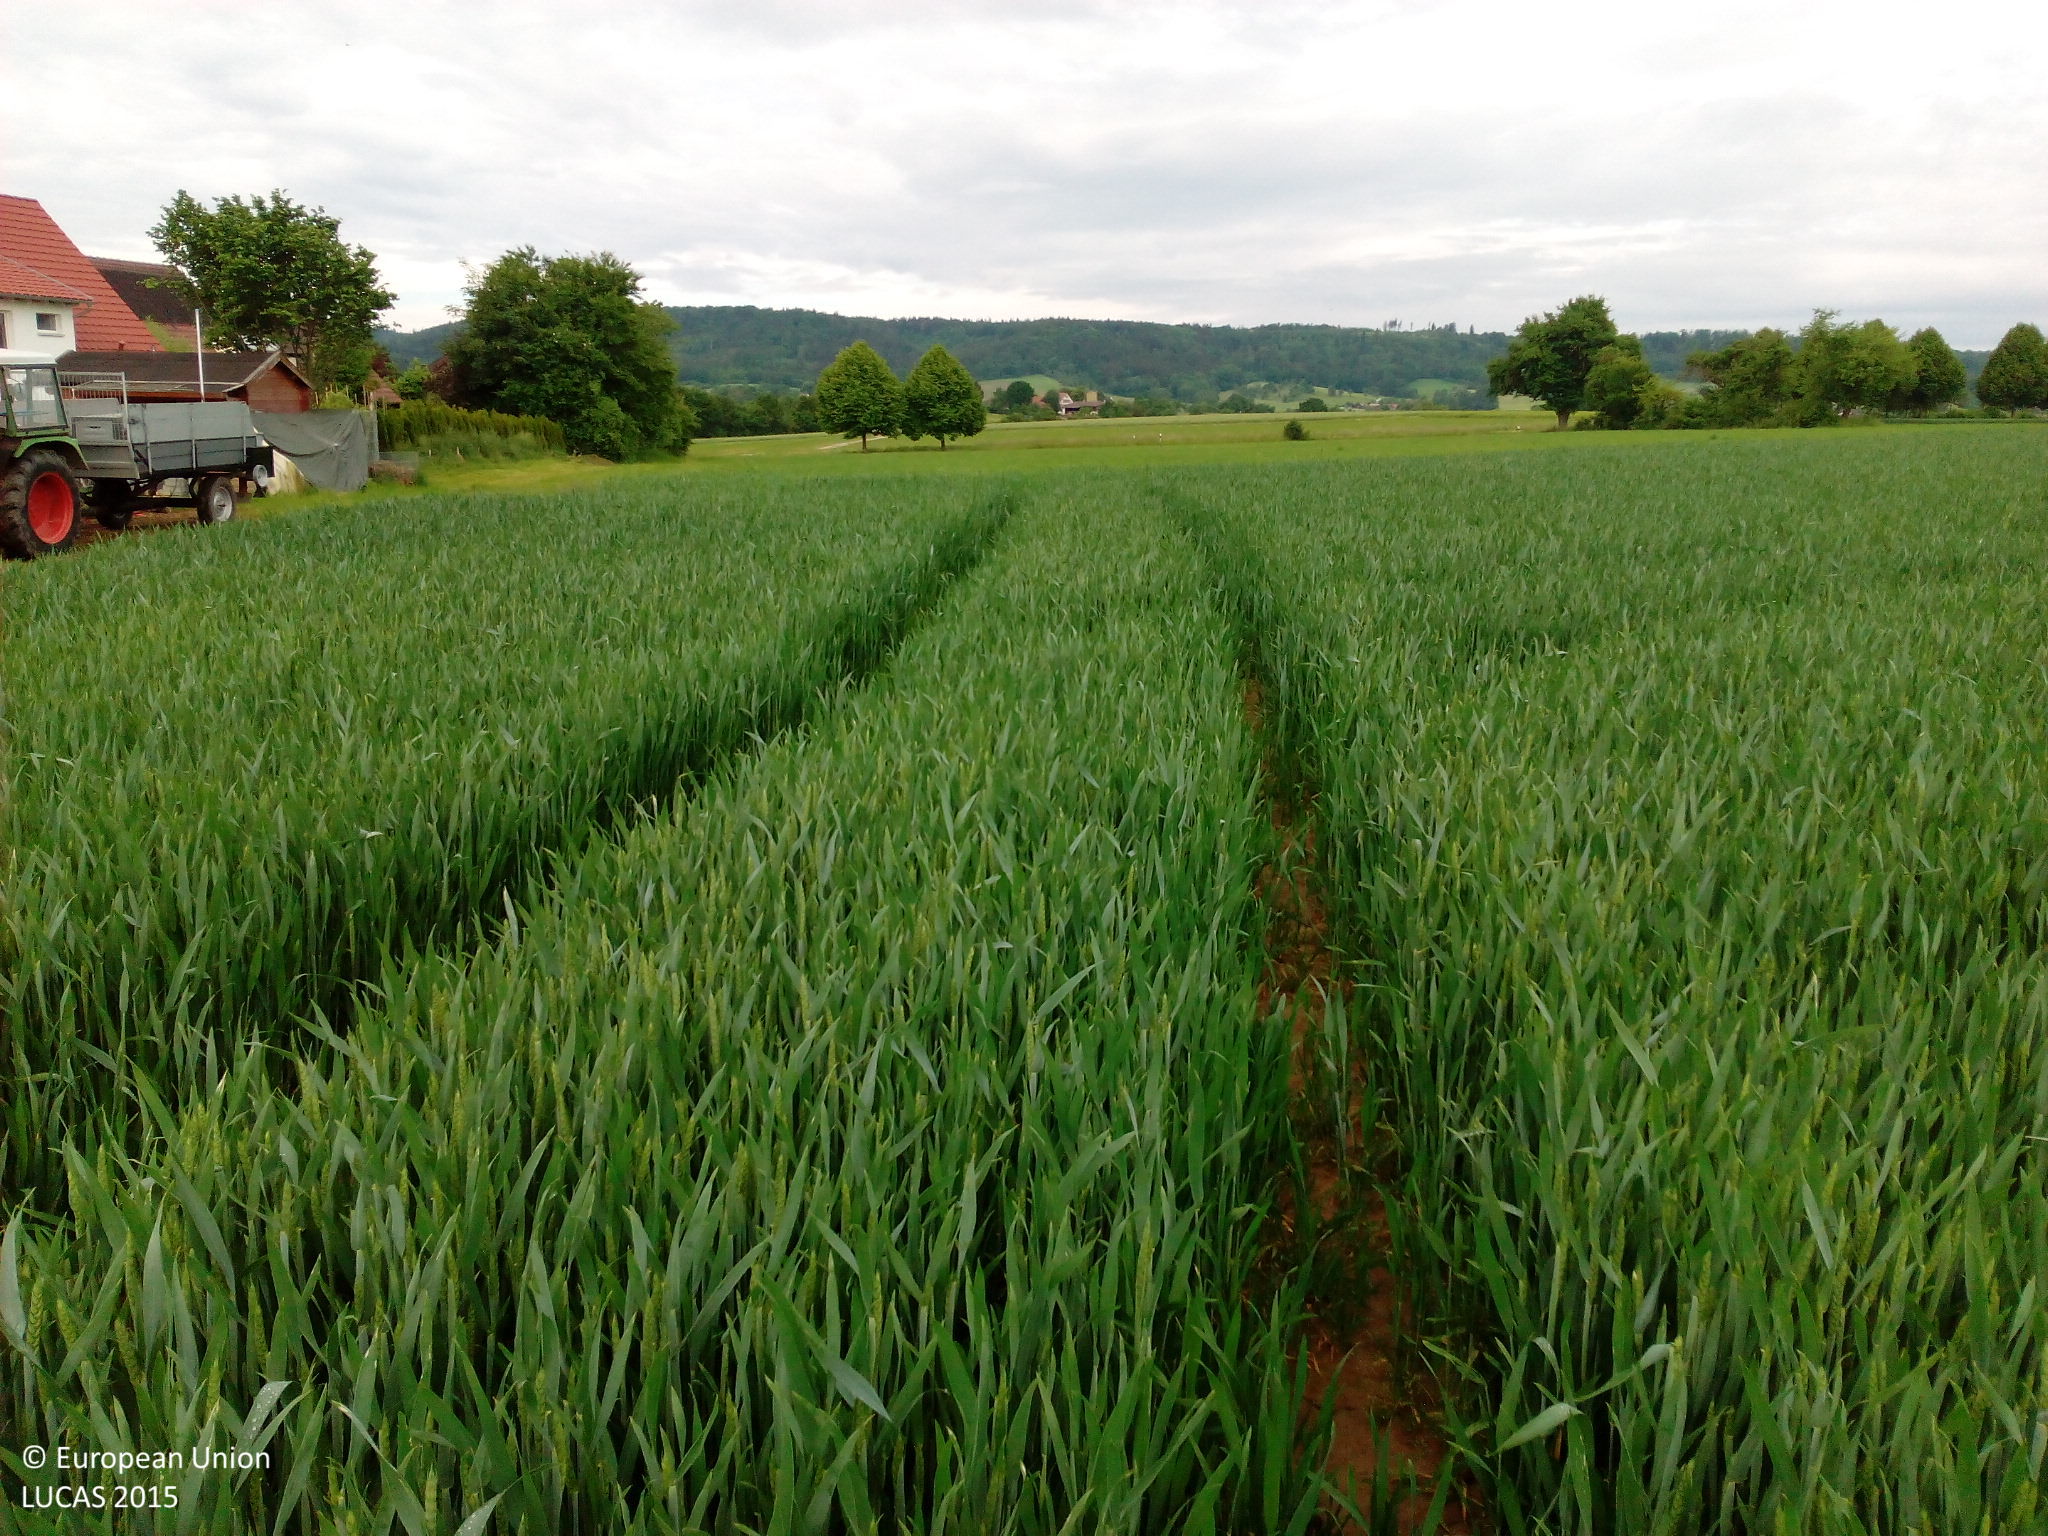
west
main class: Cropland
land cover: Common wheat
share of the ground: > 75 %
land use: Agriculture (excluding fallow land and kitchen gardens)
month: June
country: DE
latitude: 49.0867
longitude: 9.6852
